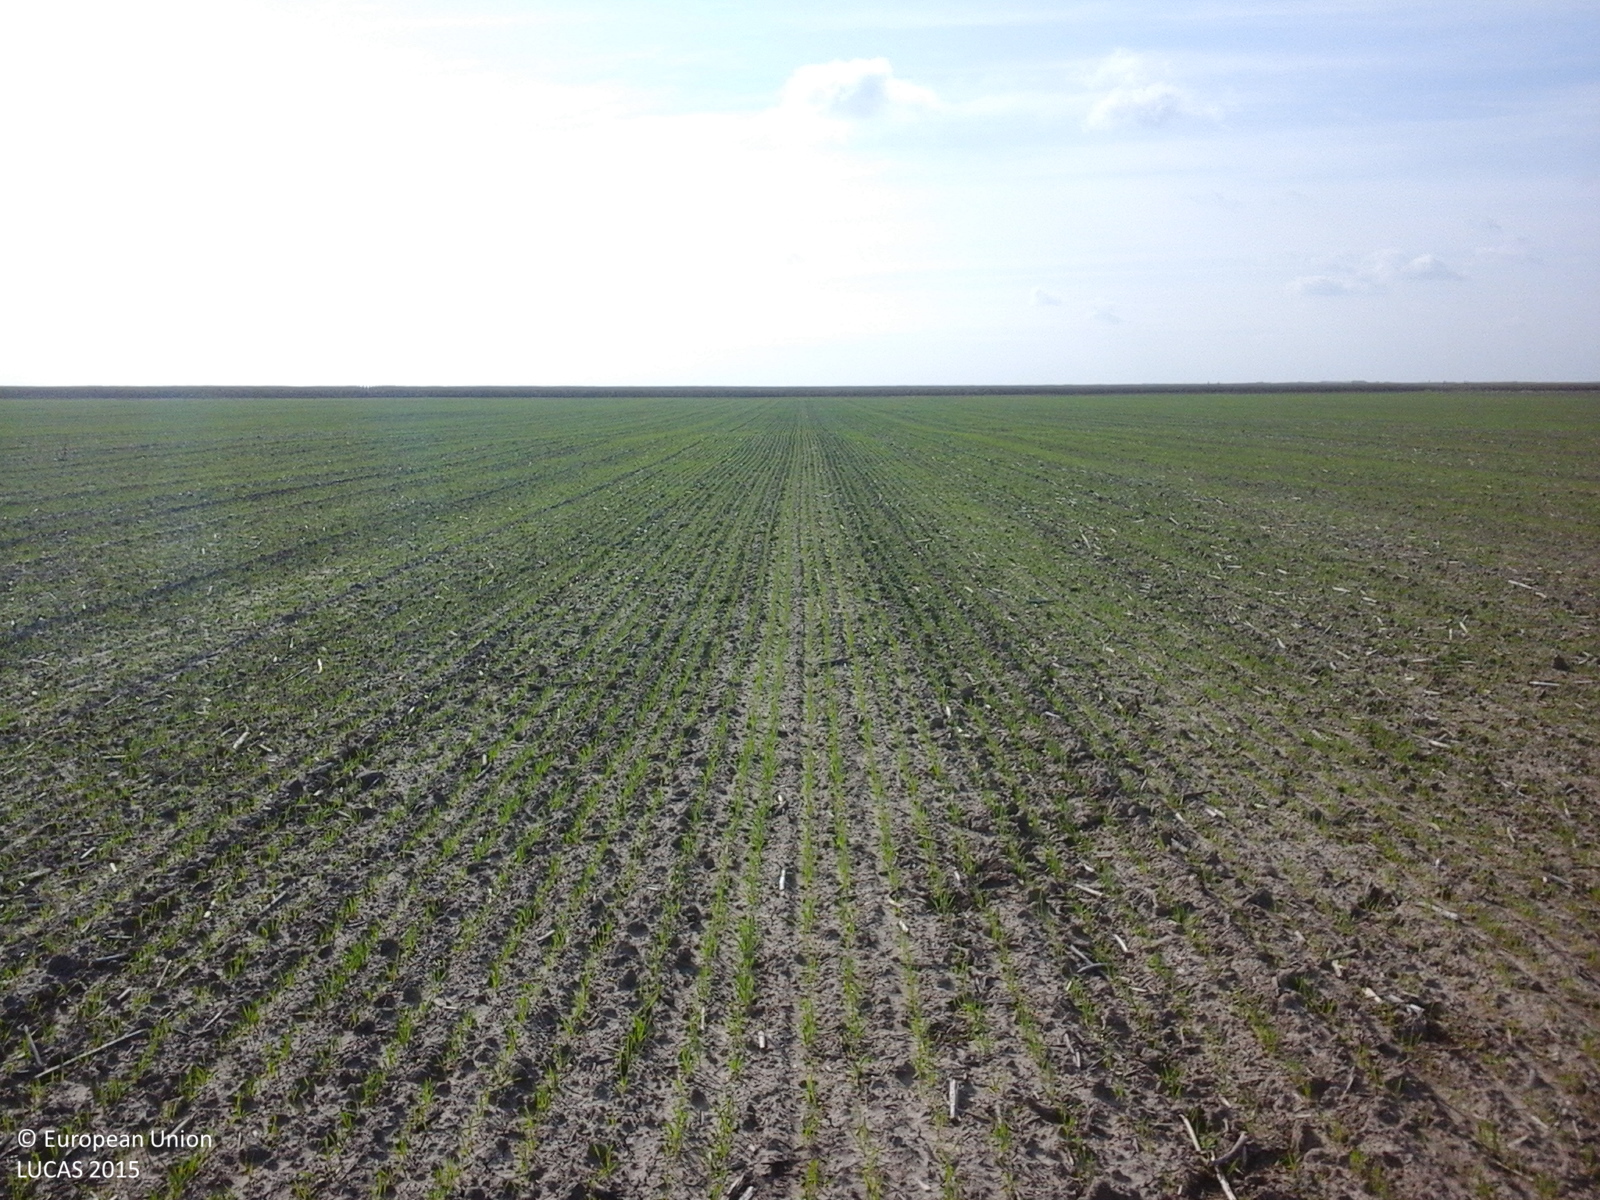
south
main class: Cropland
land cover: Common wheat
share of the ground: < 10 %
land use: Agriculture (excluding fallow land and kitchen gardens)
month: October
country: RO
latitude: 45.4885
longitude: 27.3586
